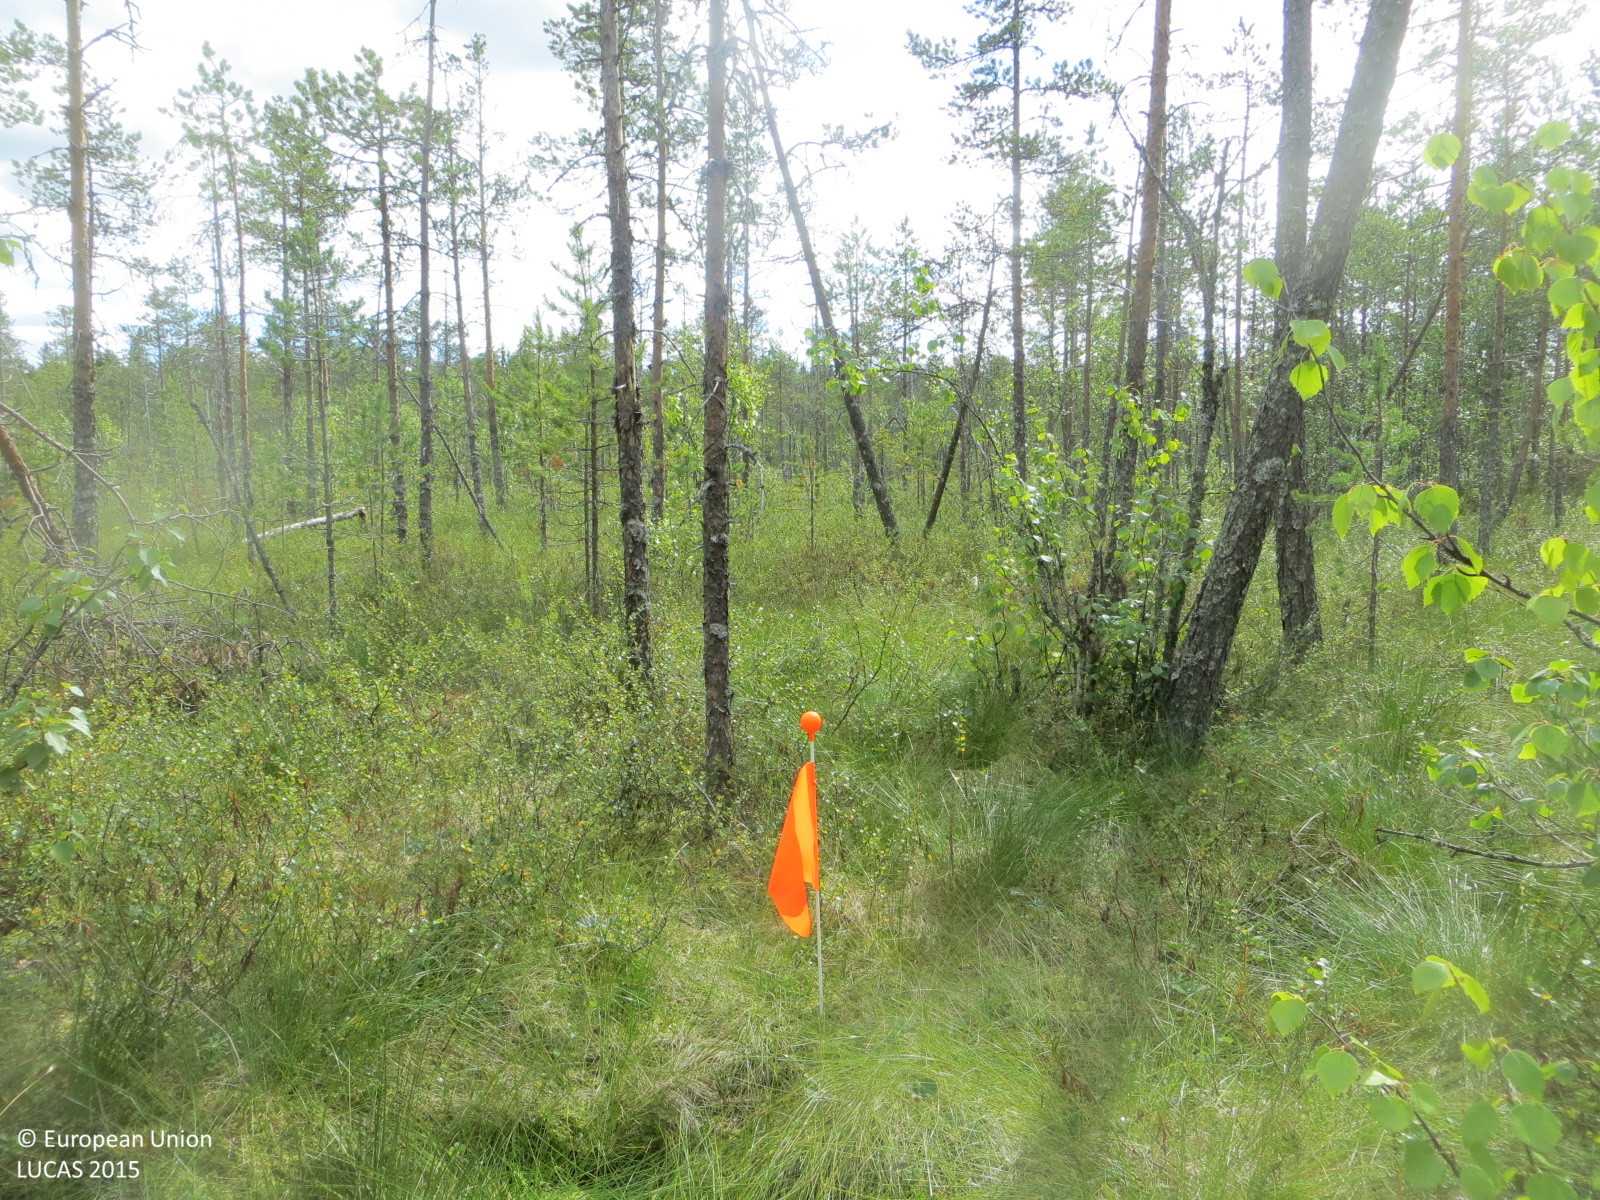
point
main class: Woodland
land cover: Pine dominated coniferous woodland
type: mire and swamp forests
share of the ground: 50 - 75 %
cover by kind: coniferous forest trees 50 %, shrubs 45 %, broadleaved forest trees 5 %
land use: Forestry
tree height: > 5 m
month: August
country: FI
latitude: 66.1886
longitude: 25.4499
